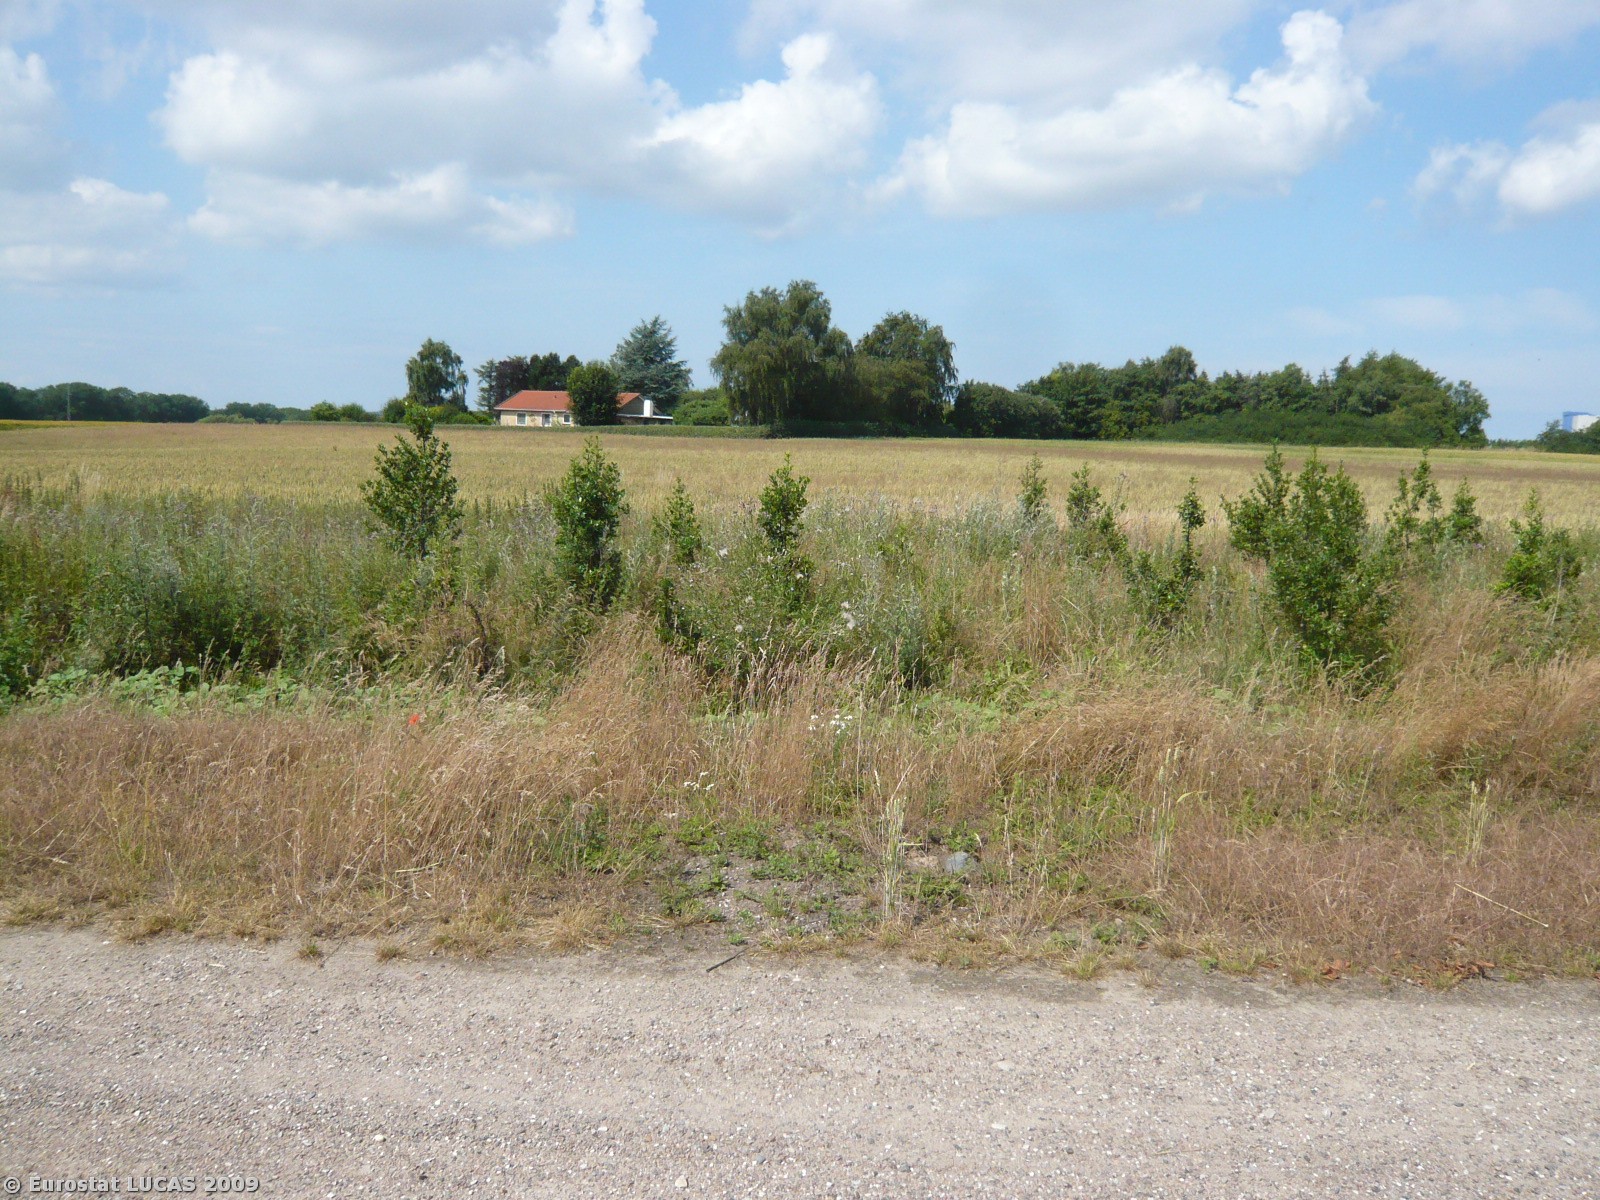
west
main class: Woodland
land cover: Broadleaved woodland
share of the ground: > 75 %
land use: Unused
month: July
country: DK
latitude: 55.8013
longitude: 11.5140
